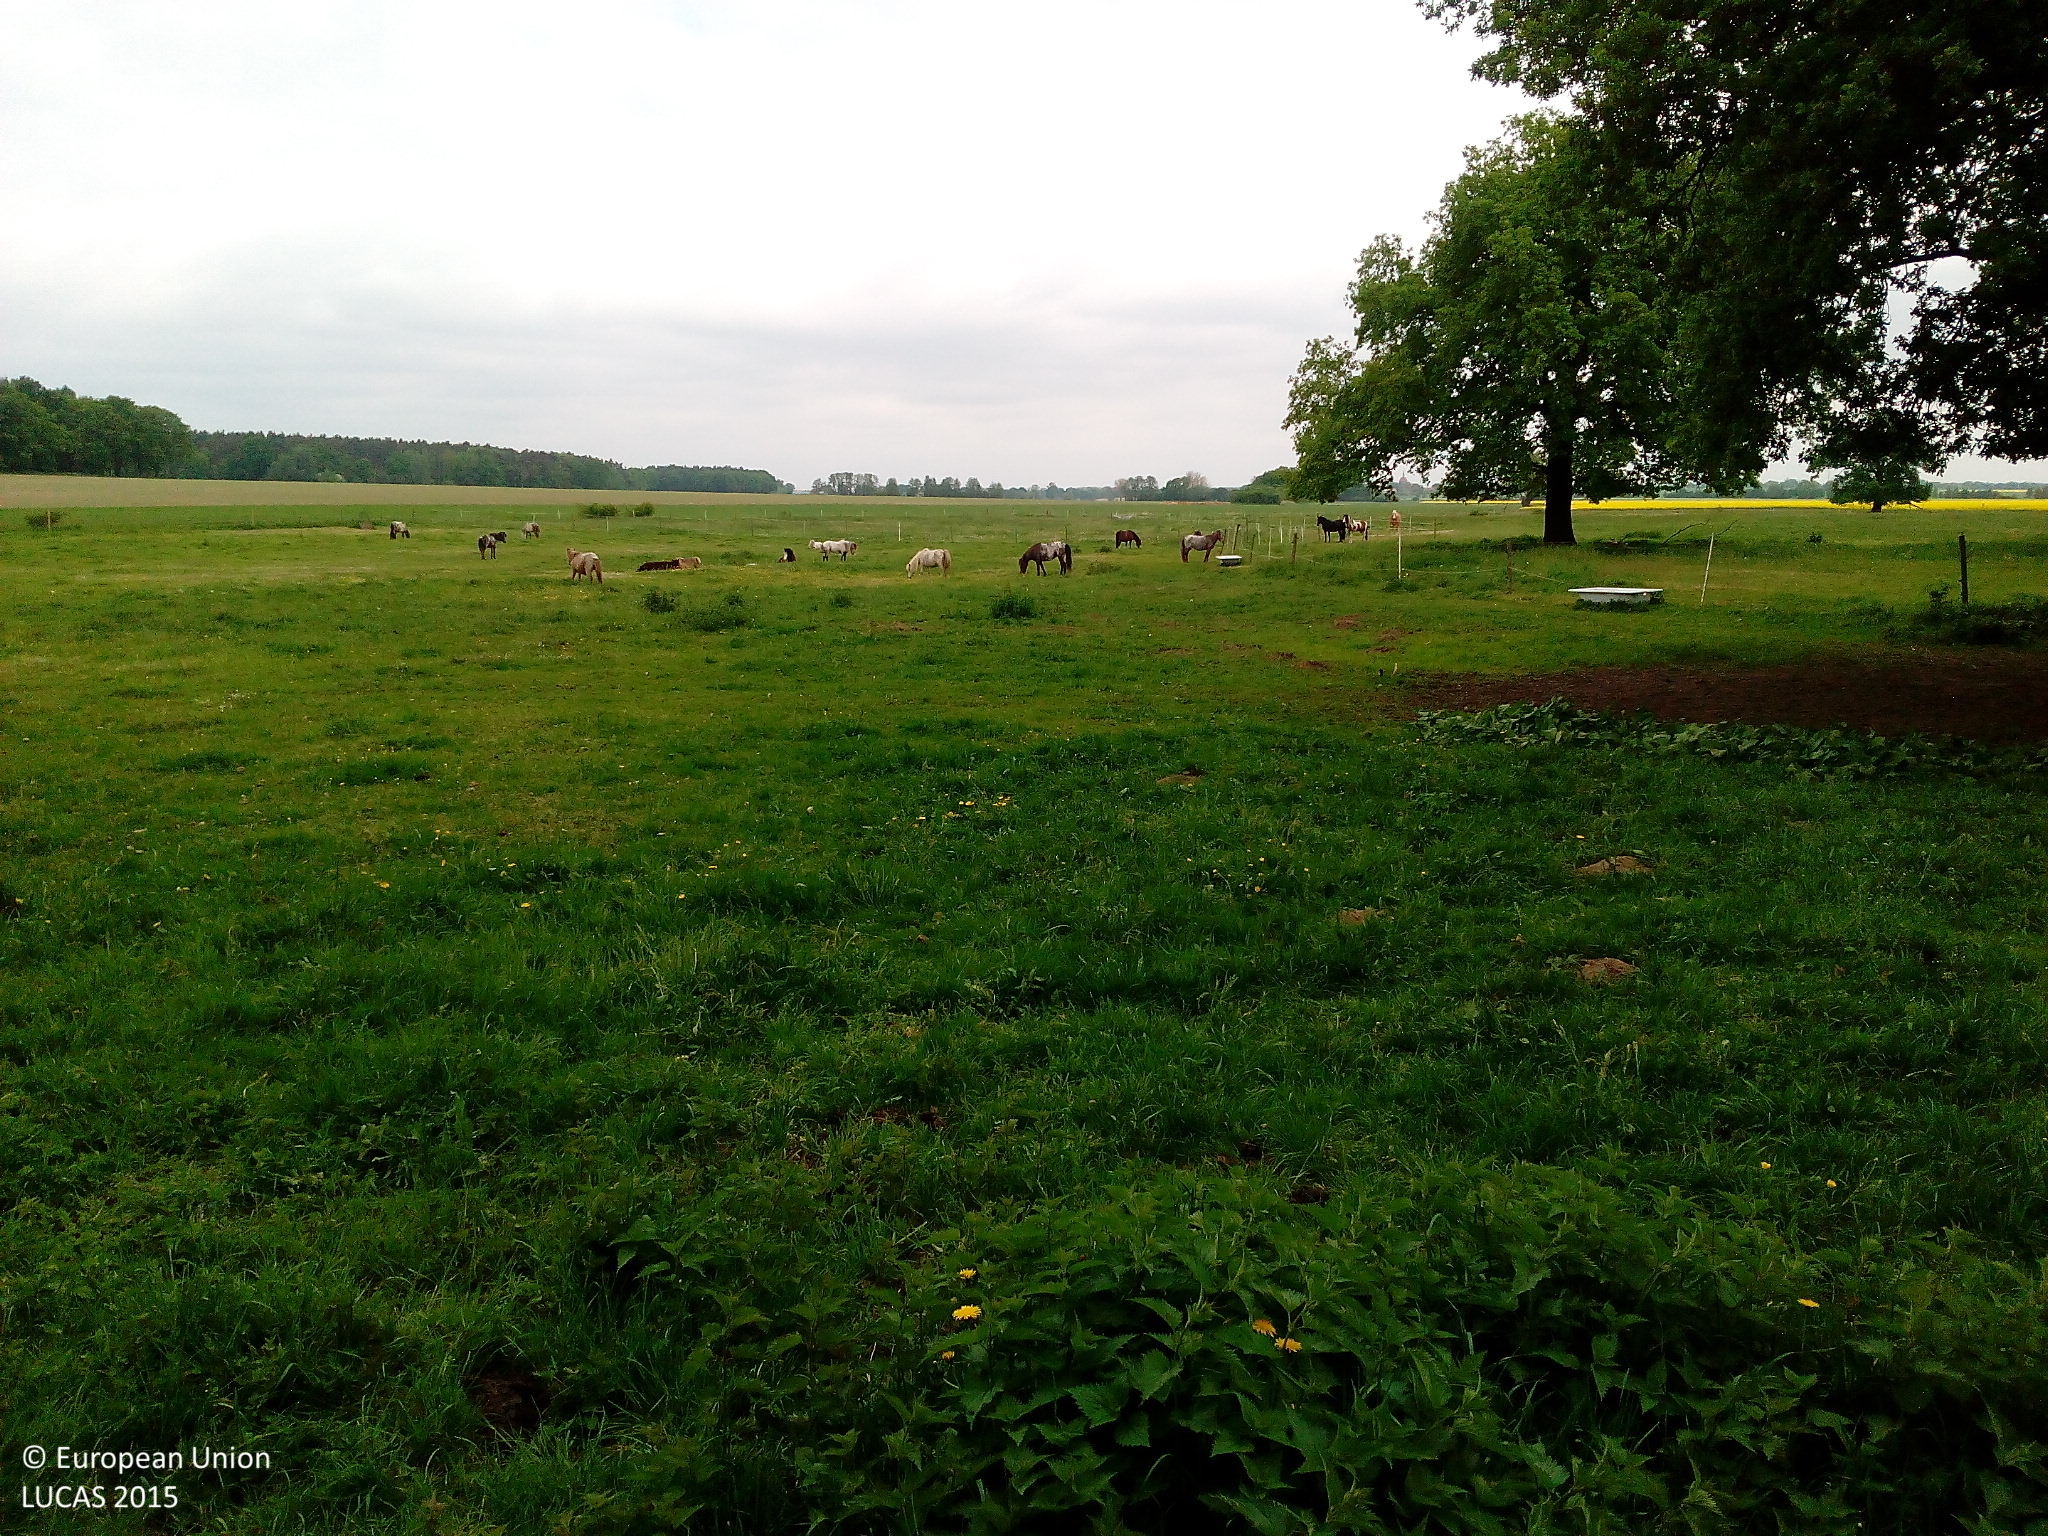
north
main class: Woodland
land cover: Broadleaved woodland
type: mesophytic deciduous forest
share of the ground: 10 - 25 %
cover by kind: herbaceous plants 80 %, broadleaved forest trees 20 %
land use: Agriculture (excluding fallow land and kitchen gardens)
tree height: > 5 m
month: May
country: DE
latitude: 52.8159
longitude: 11.6168
